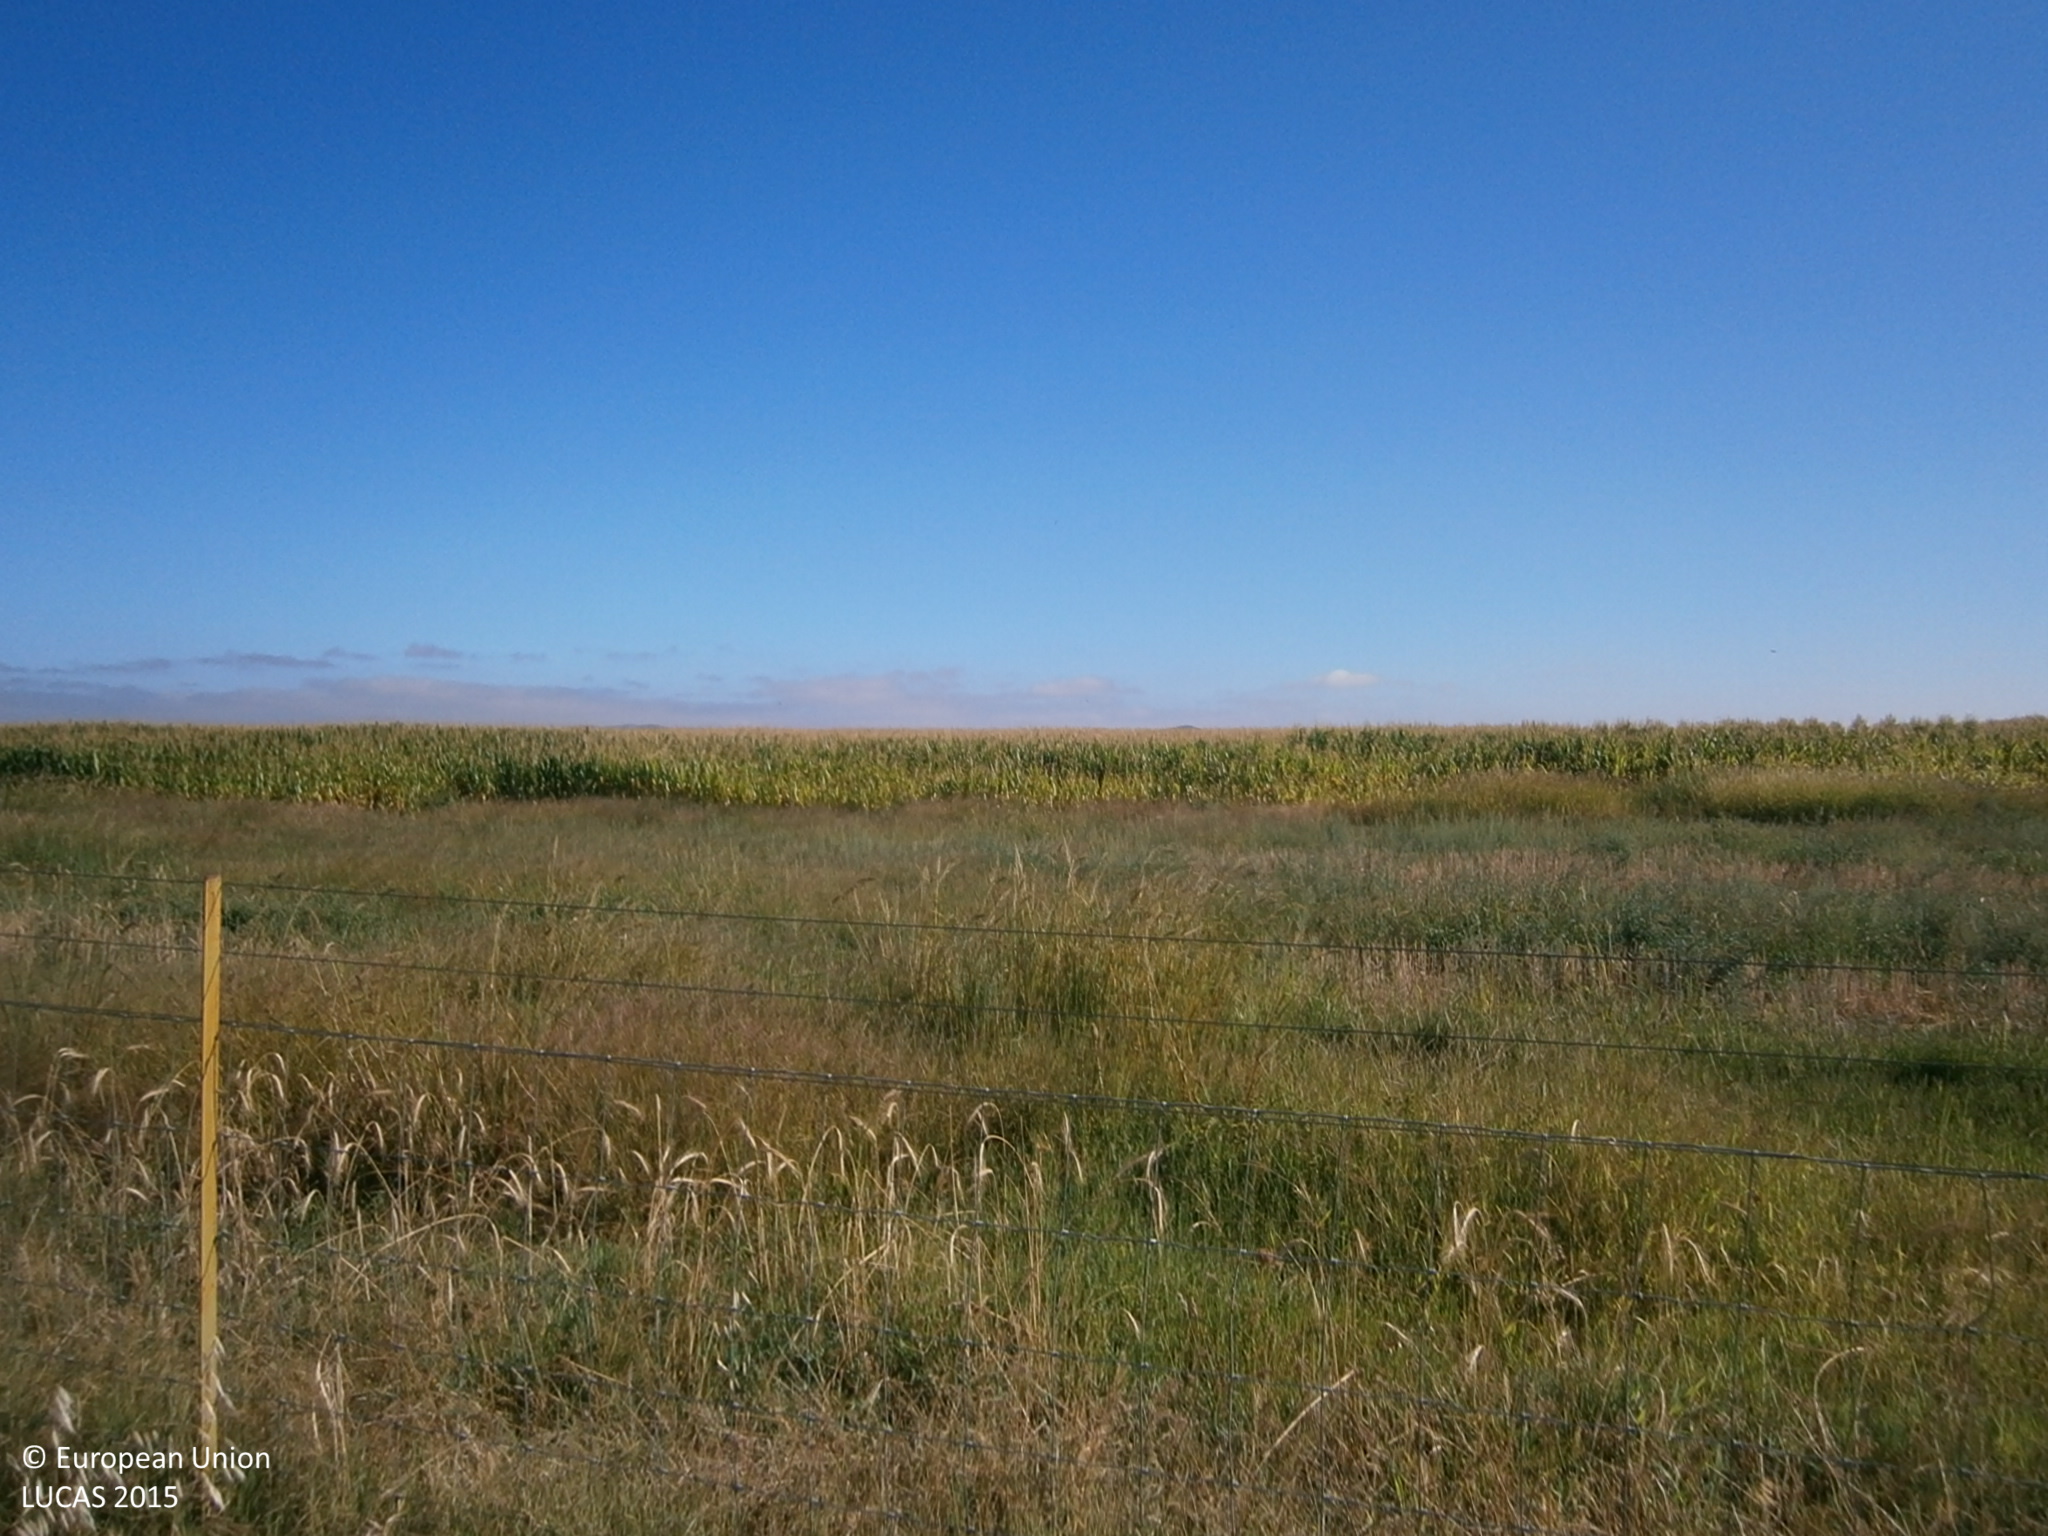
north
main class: Cropland
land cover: Maize
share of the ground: > 75 %
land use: Agriculture (excluding fallow land and kitchen gardens)
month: July
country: ES
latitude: 38.7311
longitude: -7.2240
